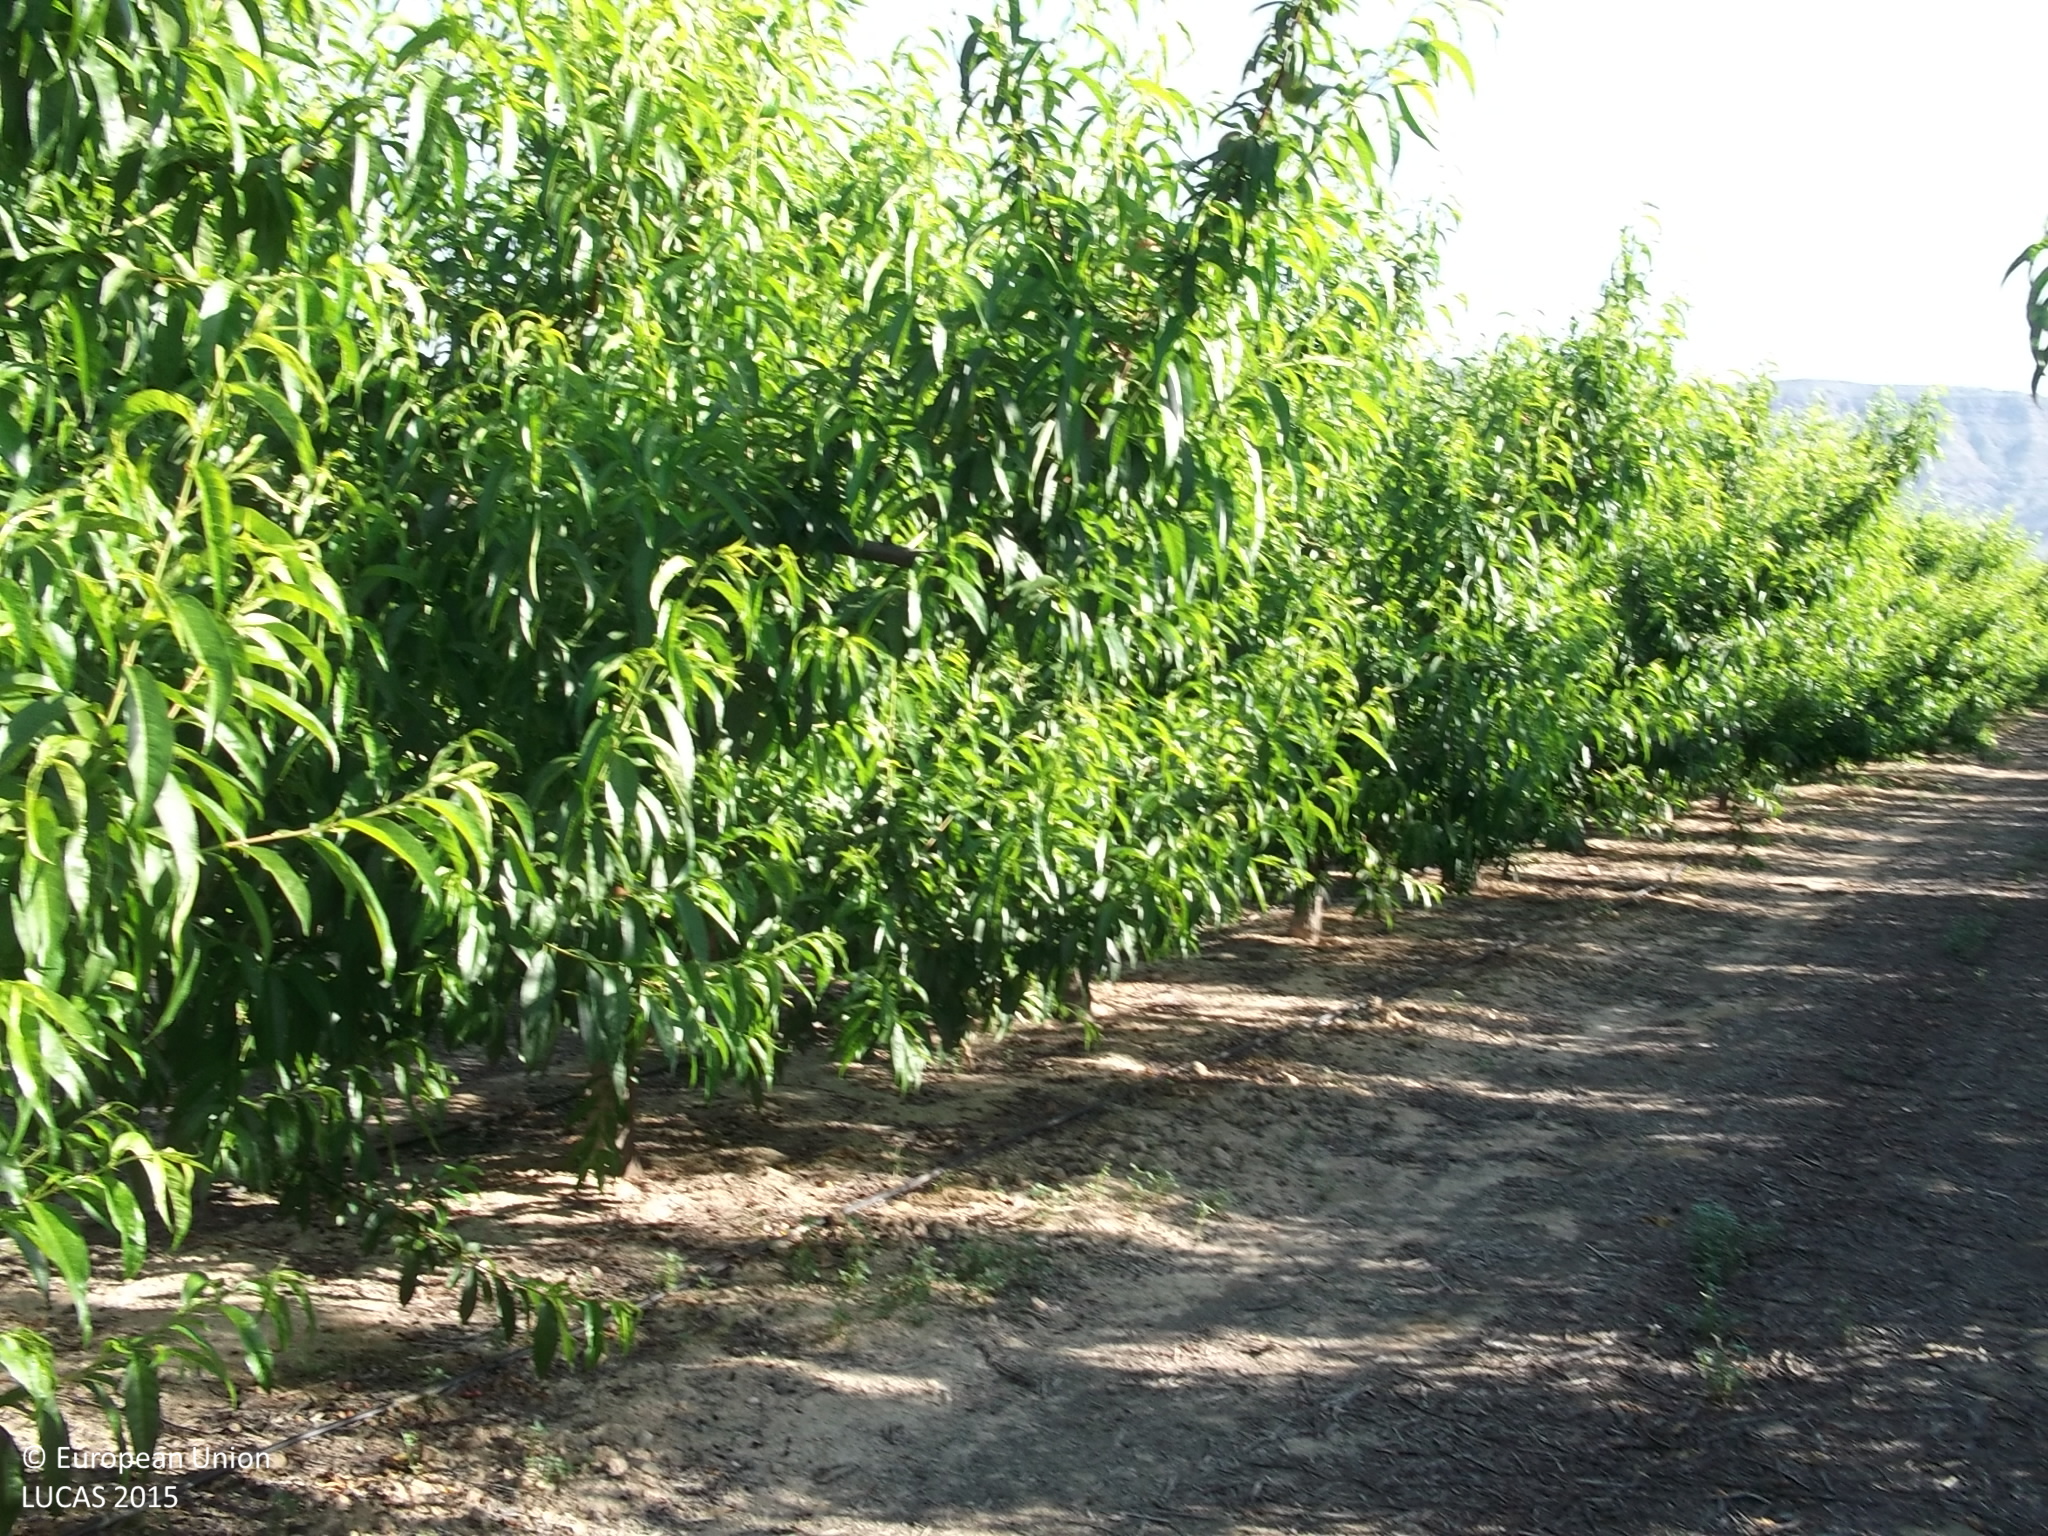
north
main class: Cropland
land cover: Other fruit trees and berries
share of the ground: 25 - 50 %
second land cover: Other bare soil
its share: > 75 %
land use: Agriculture (excluding fallow land and kitchen gardens)
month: May
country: ES
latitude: 38.2052
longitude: -1.3045
